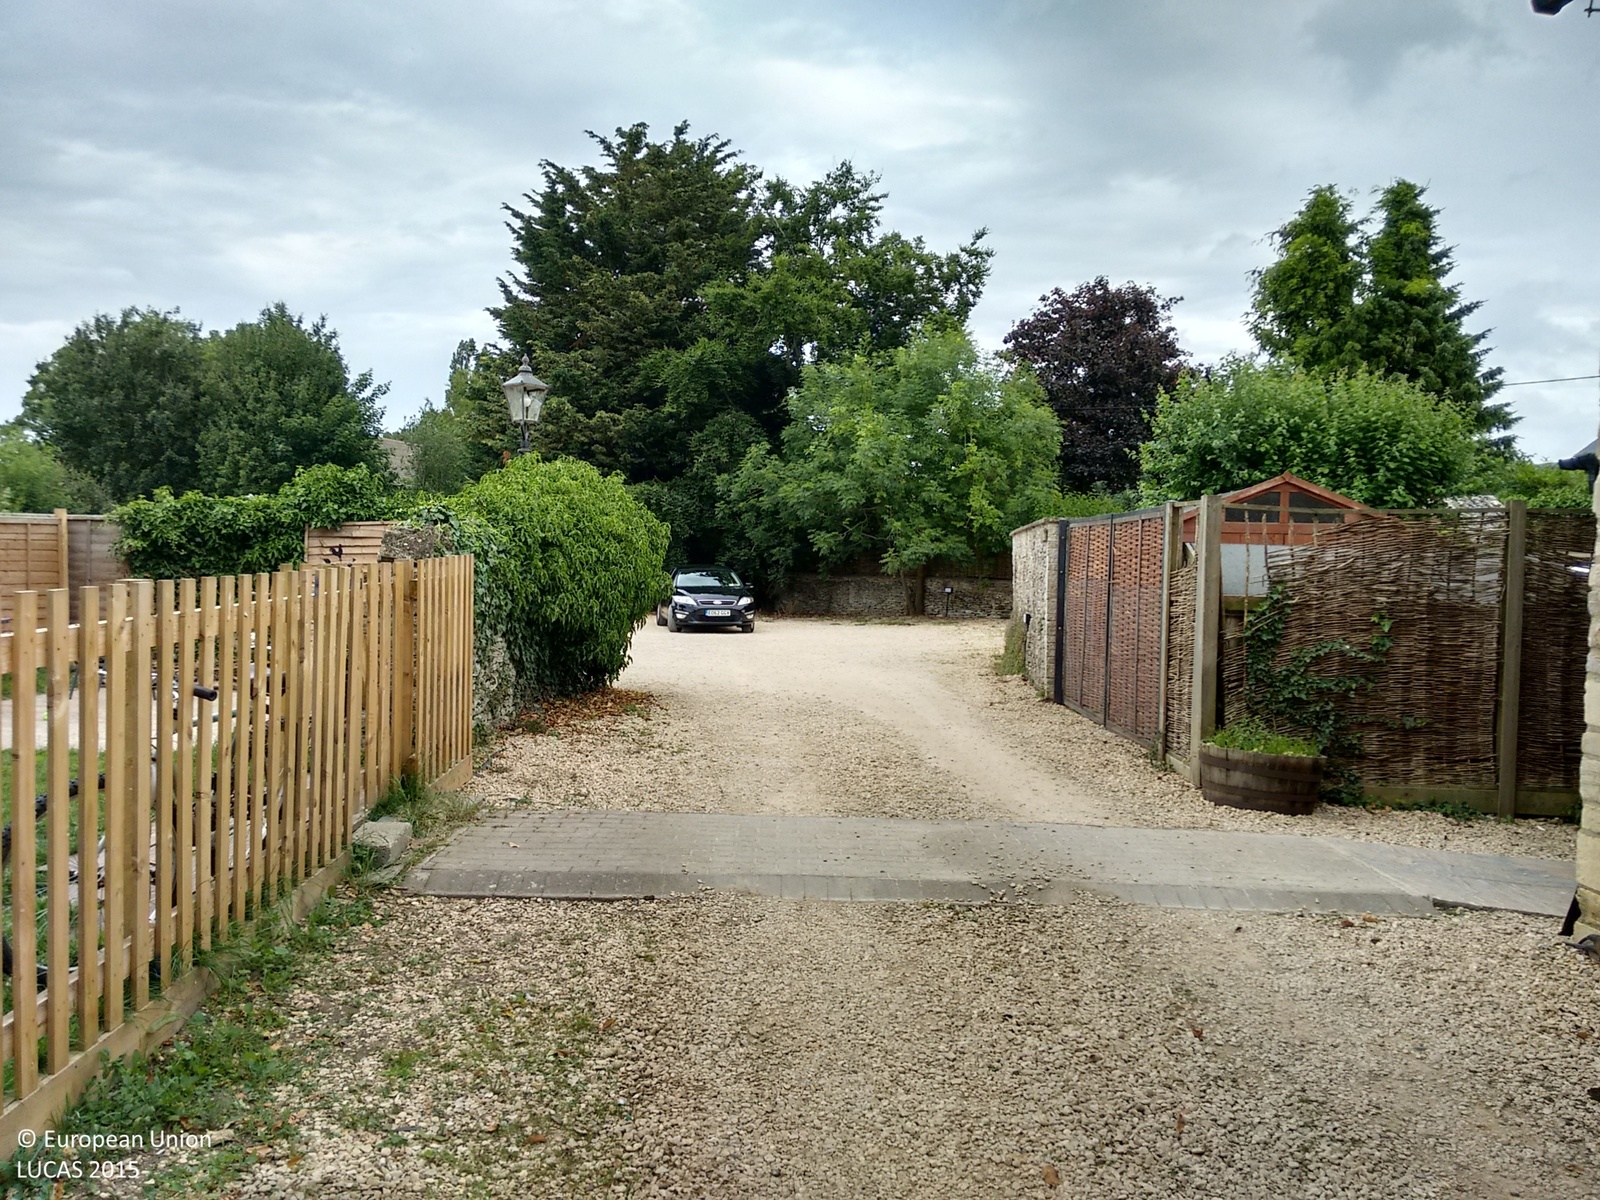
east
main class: Woodland
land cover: Broadleaved woodland
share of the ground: 50 - 75 %
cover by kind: broadleaved forest trees 60 %, herbaceous plants 20 %
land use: Residential
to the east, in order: Broadleaved woodland; Artificial constructions in urban areas
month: June
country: GB
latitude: 51.7168
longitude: -1.5886
